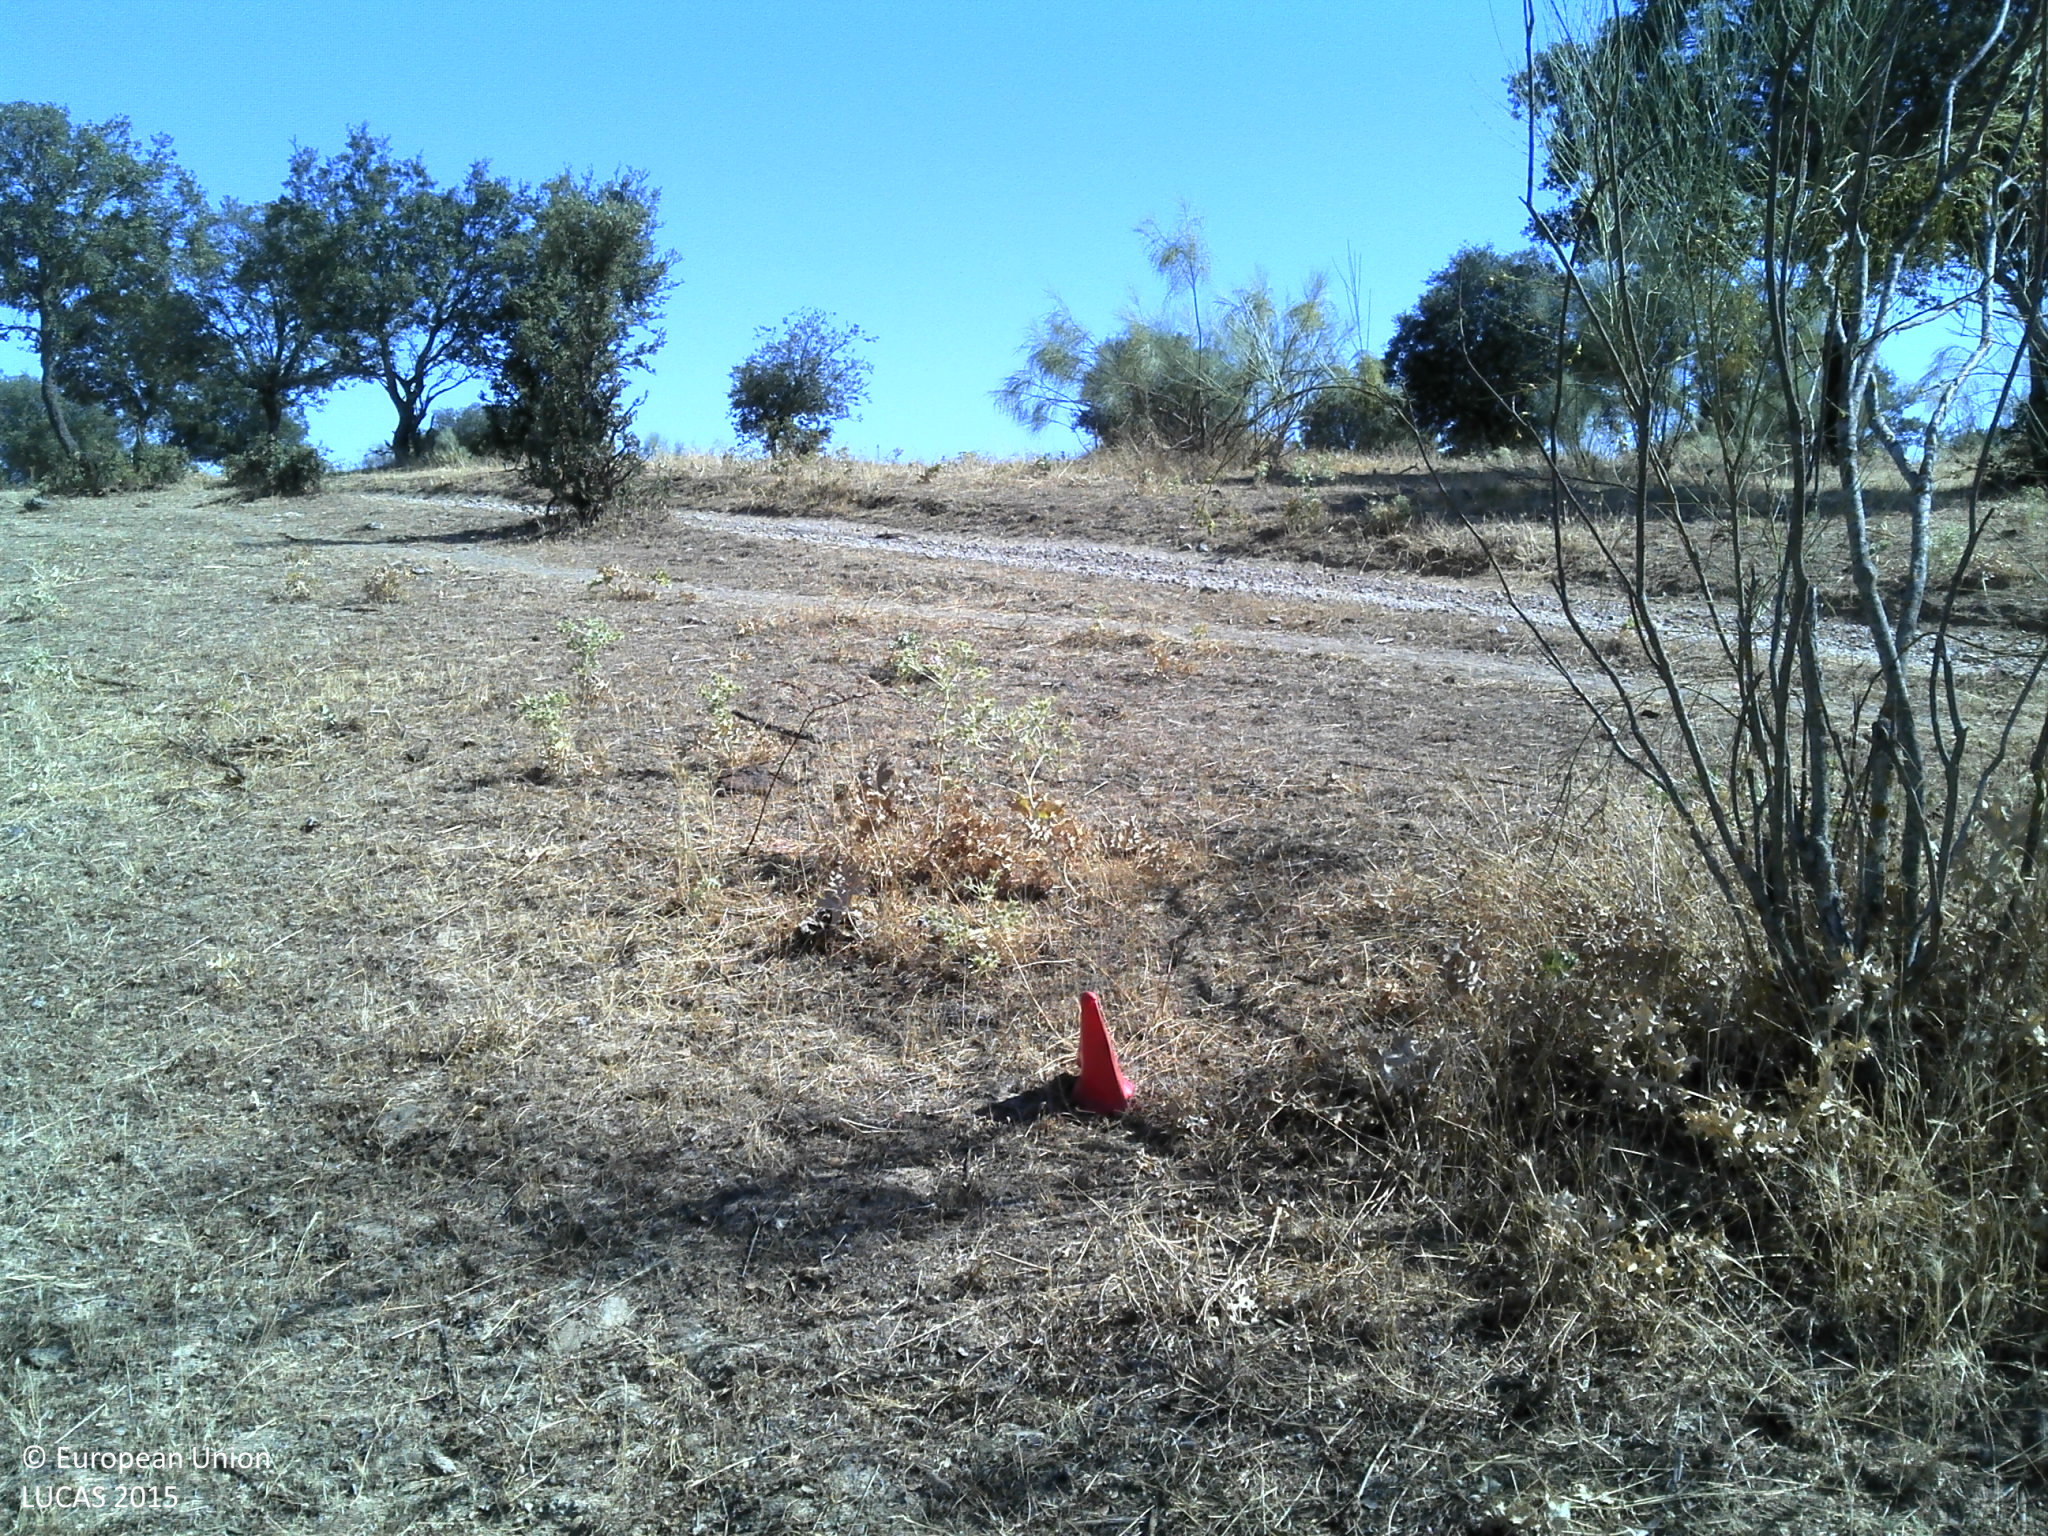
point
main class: Woodland
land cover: Broadleaved woodland
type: broadleaved evergreen forest
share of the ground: 25 - 50 %
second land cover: Grassland without tree/shrub cover
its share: 25 - 50 %
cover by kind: unconsolidated bare surface 40 %, broadleaved forest trees 35 %, herbaceous plants 25 %
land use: Forestry
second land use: Agriculture (excluding fallow land and kitchen gardens)
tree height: > 5 m
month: July
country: PT
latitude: 38.1494
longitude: -7.3756
